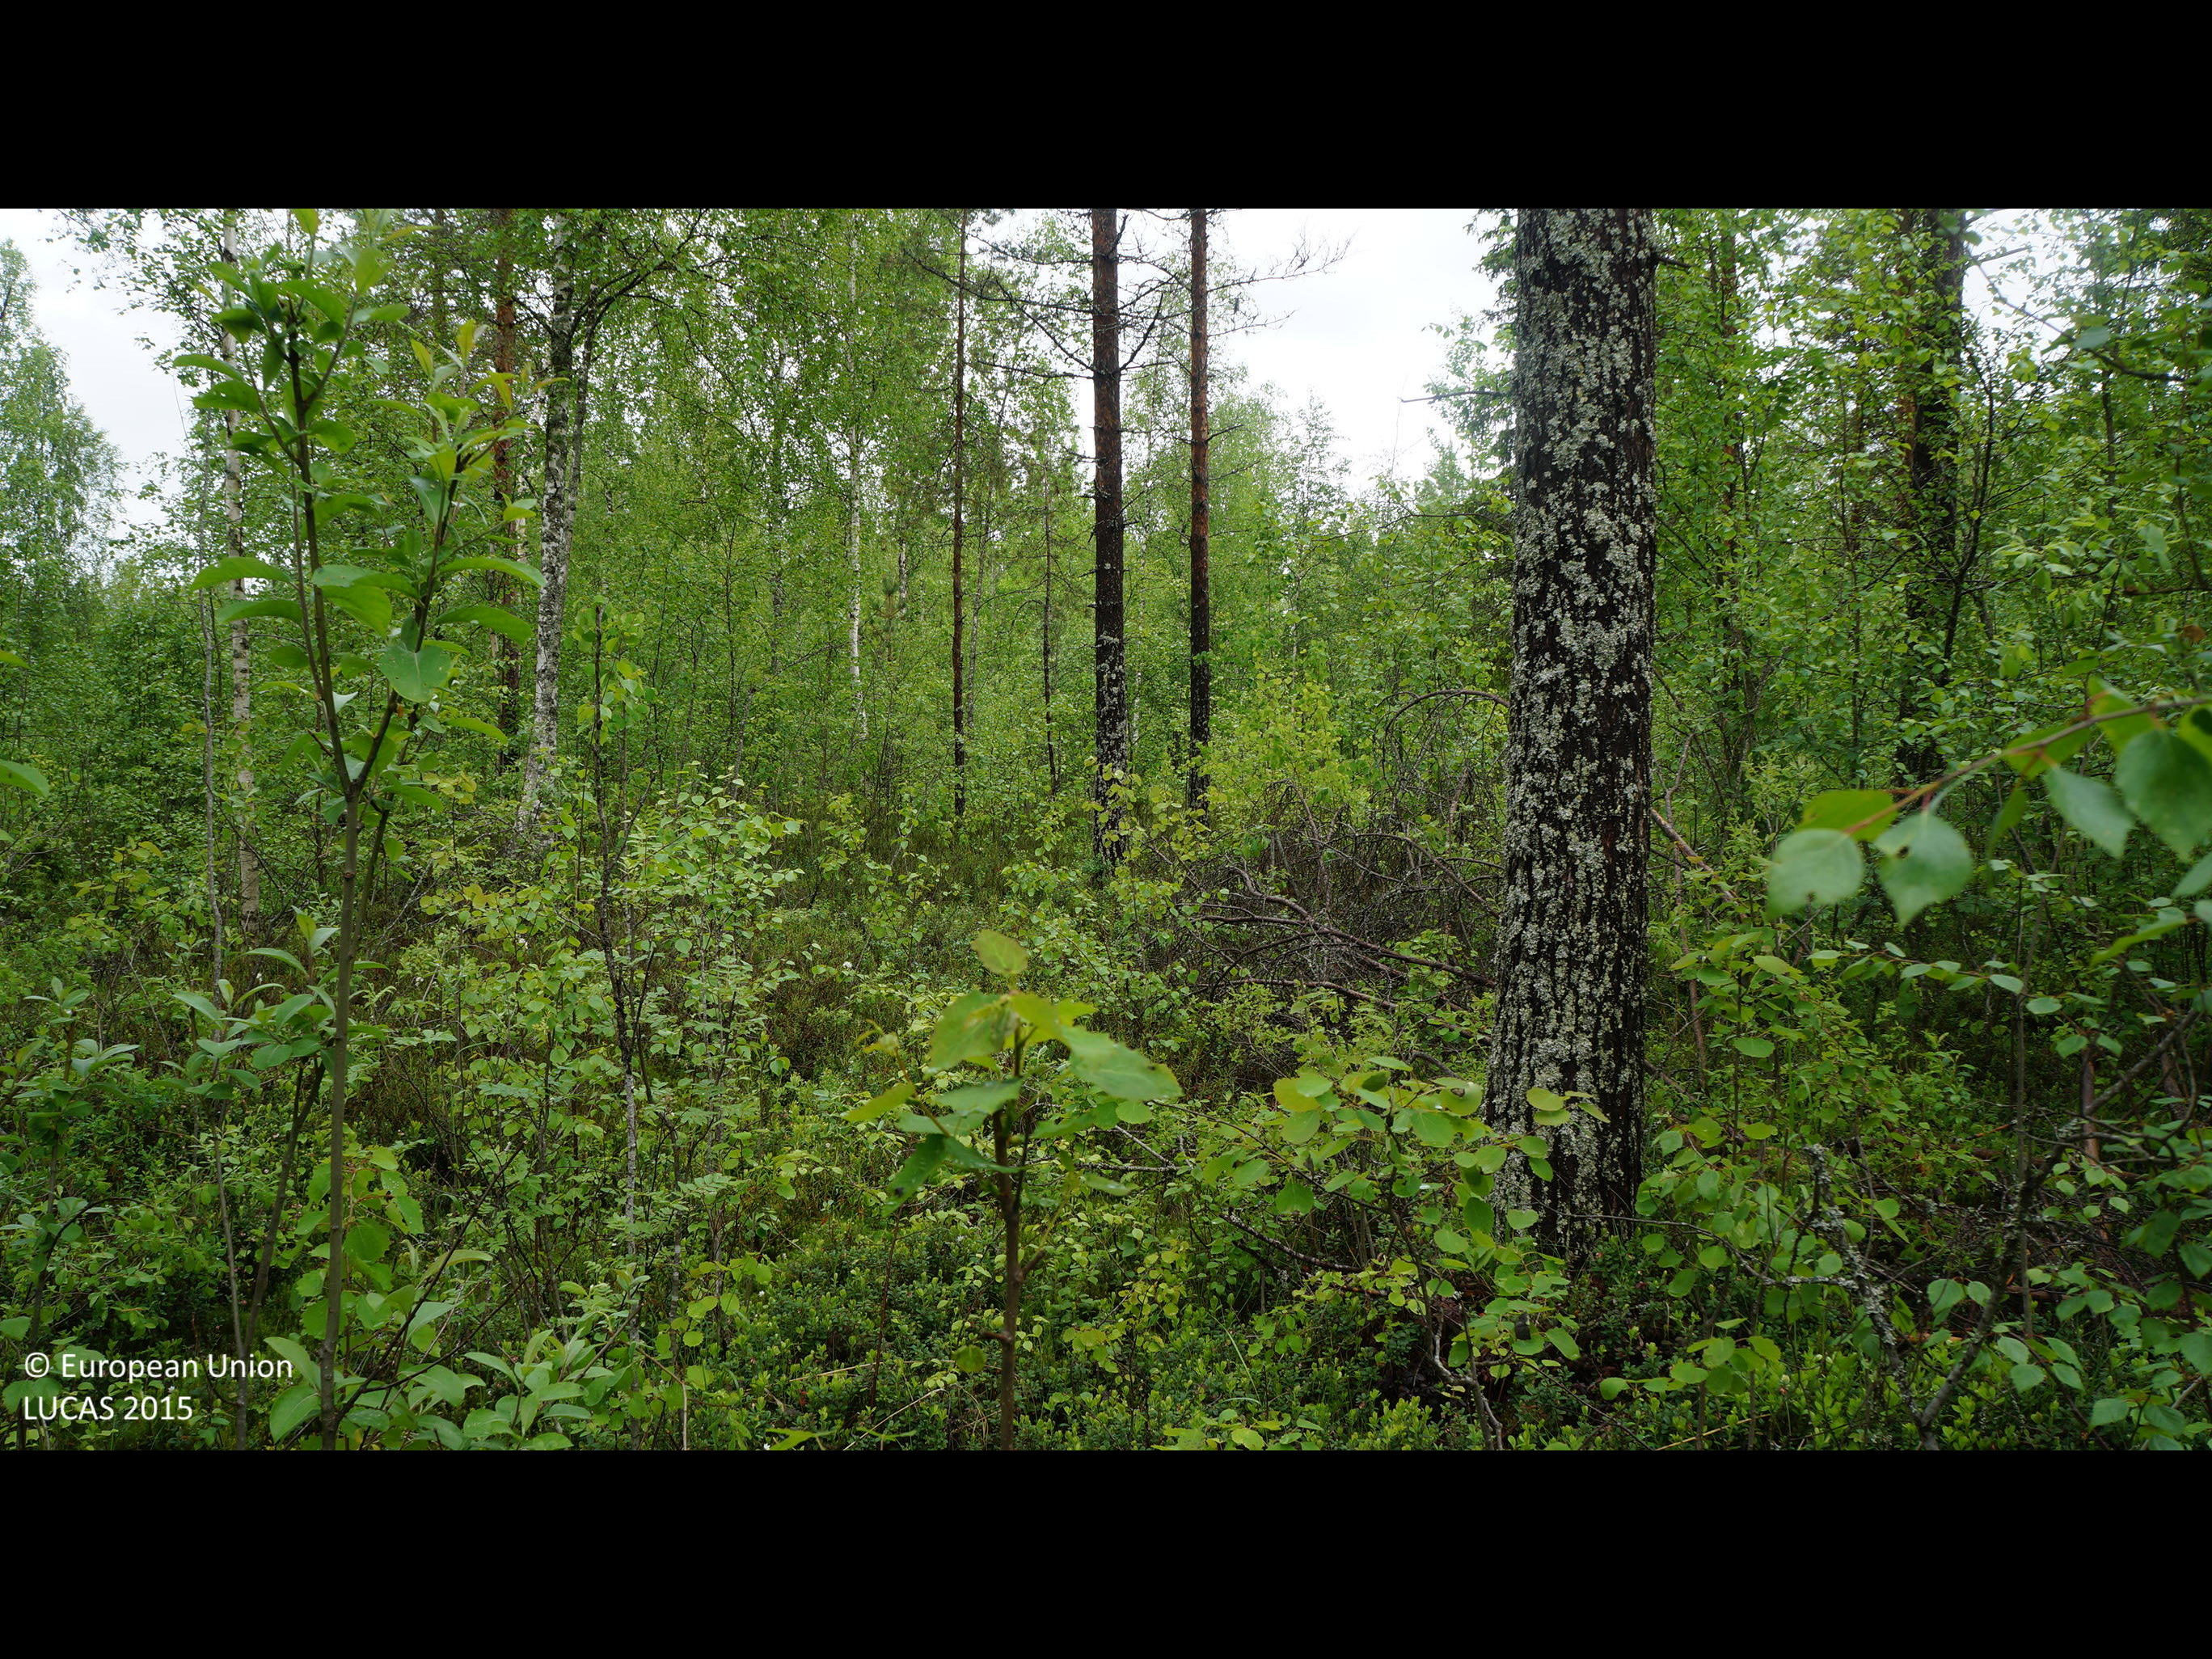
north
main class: Woodland
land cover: Pine dominated mixed woodland
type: boreal forest
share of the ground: 50 - 75 %
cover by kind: coniferous forest trees 35 %, shrubs 30 %, broadleaved forest trees 25 %, lichens and mosses 10 %
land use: Forestry
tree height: > 5 m
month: June
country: FI
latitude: 64.6827
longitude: 25.3206
